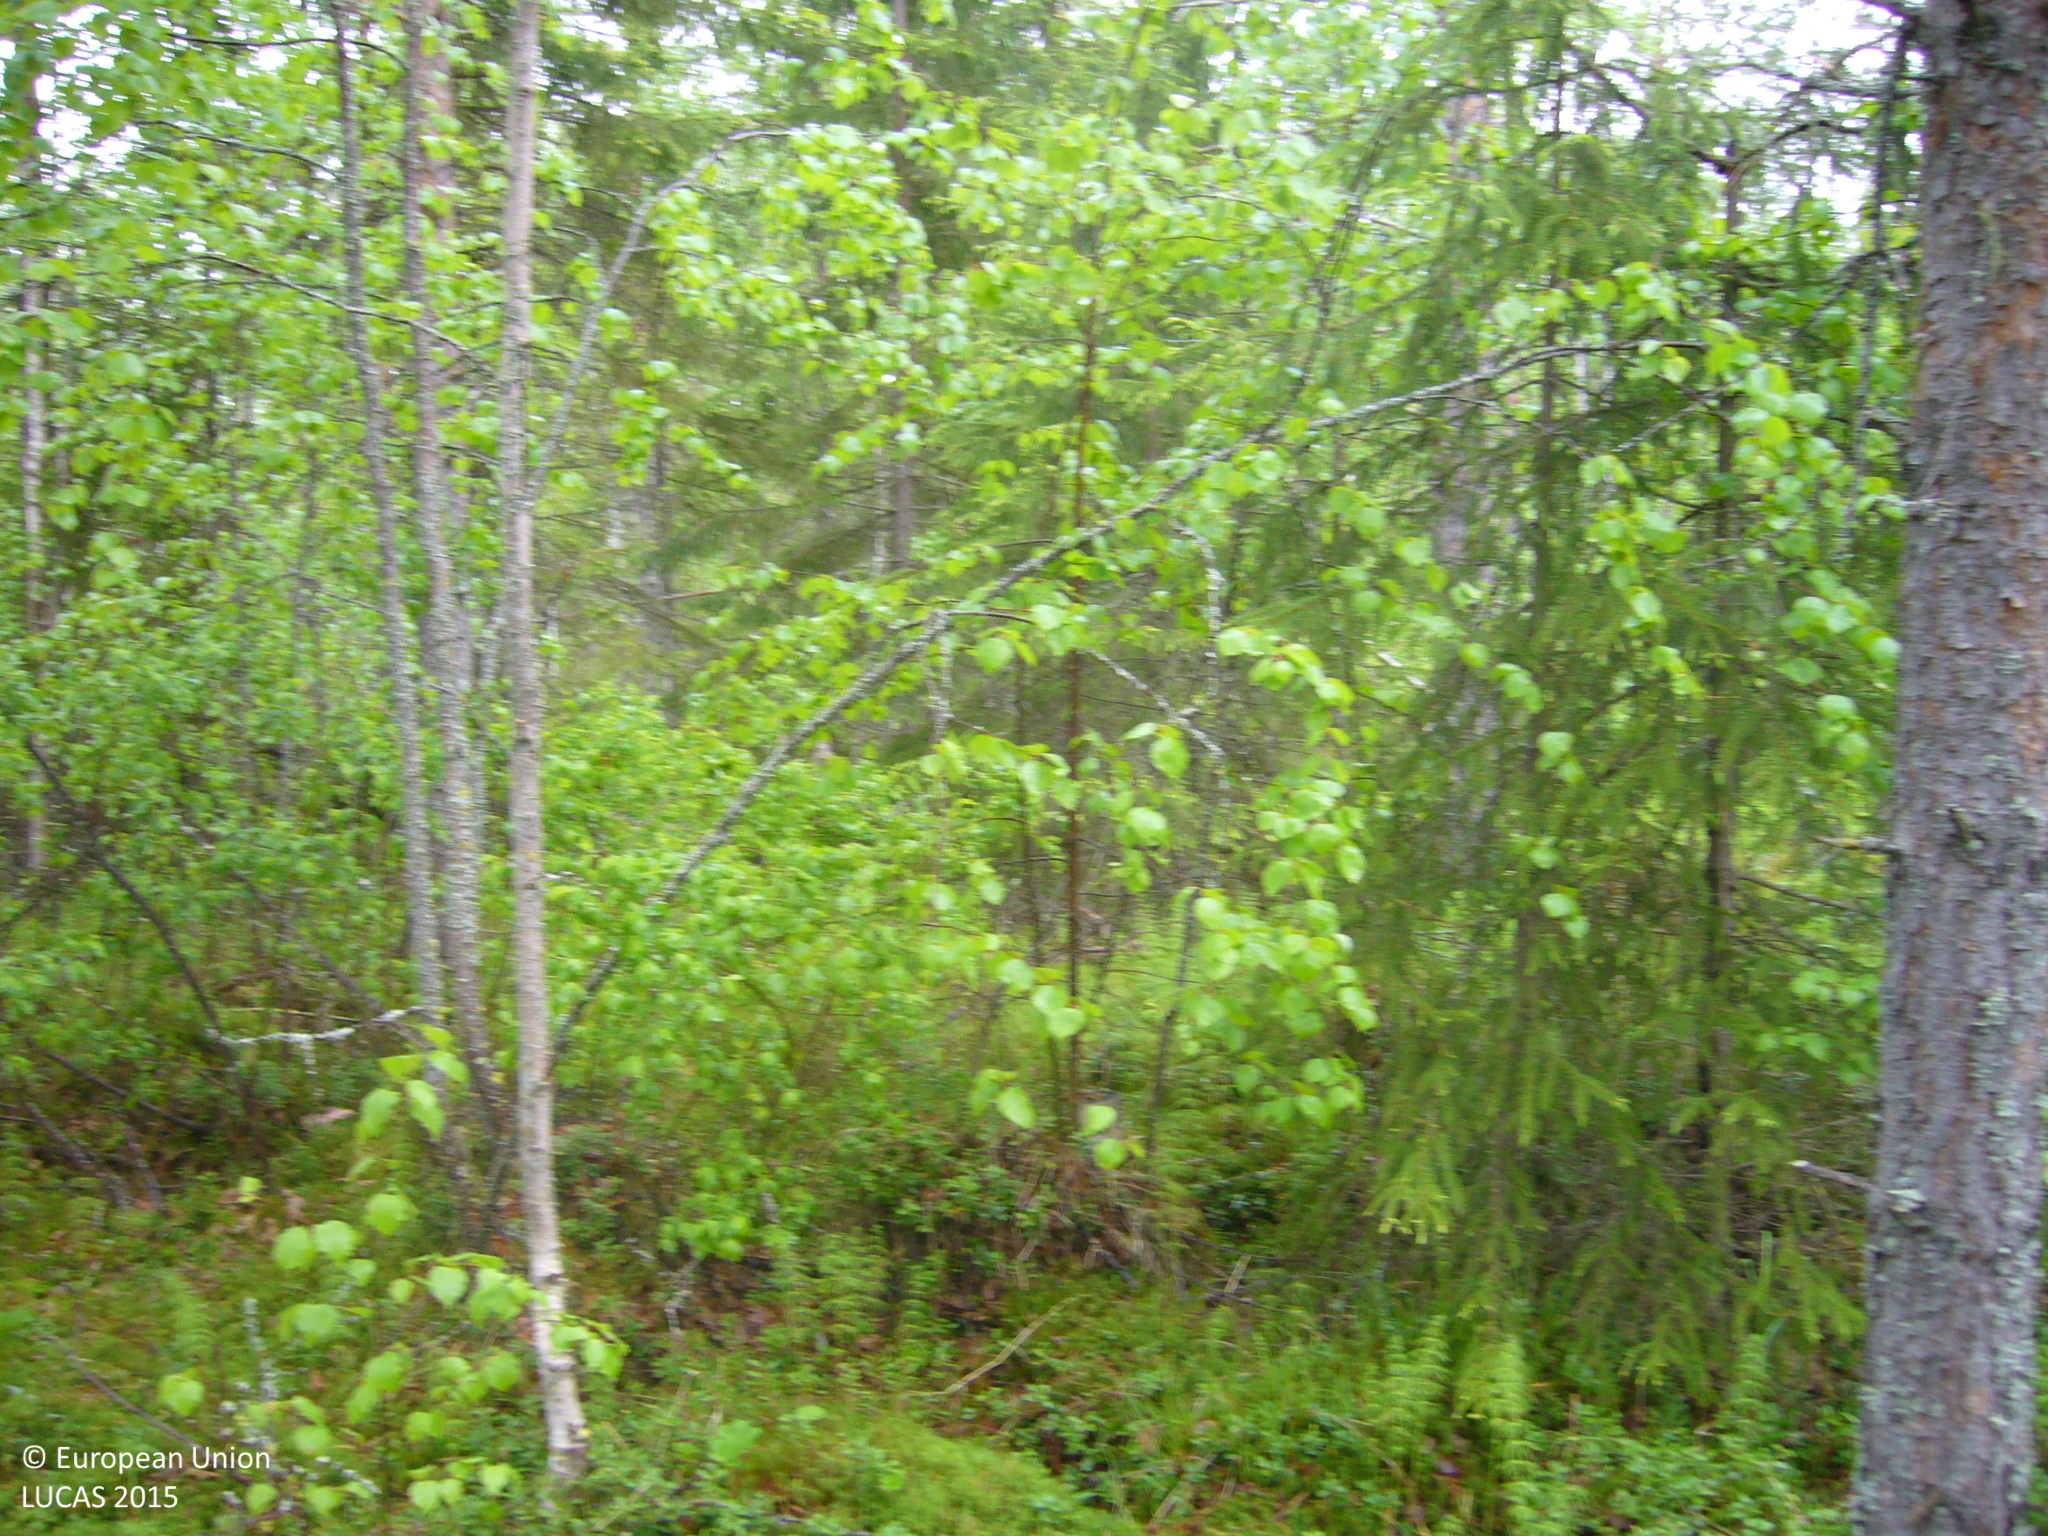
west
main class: Woodland
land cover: Pine dominated mixed woodland
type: boreal forest
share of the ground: 50 - 75 %
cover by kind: broadleaved forest trees 40 %, coniferous forest trees 30 %, shrubs 30 %
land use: Forestry
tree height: > 5 m
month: June
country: FI
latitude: 63.2704
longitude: 26.2851
